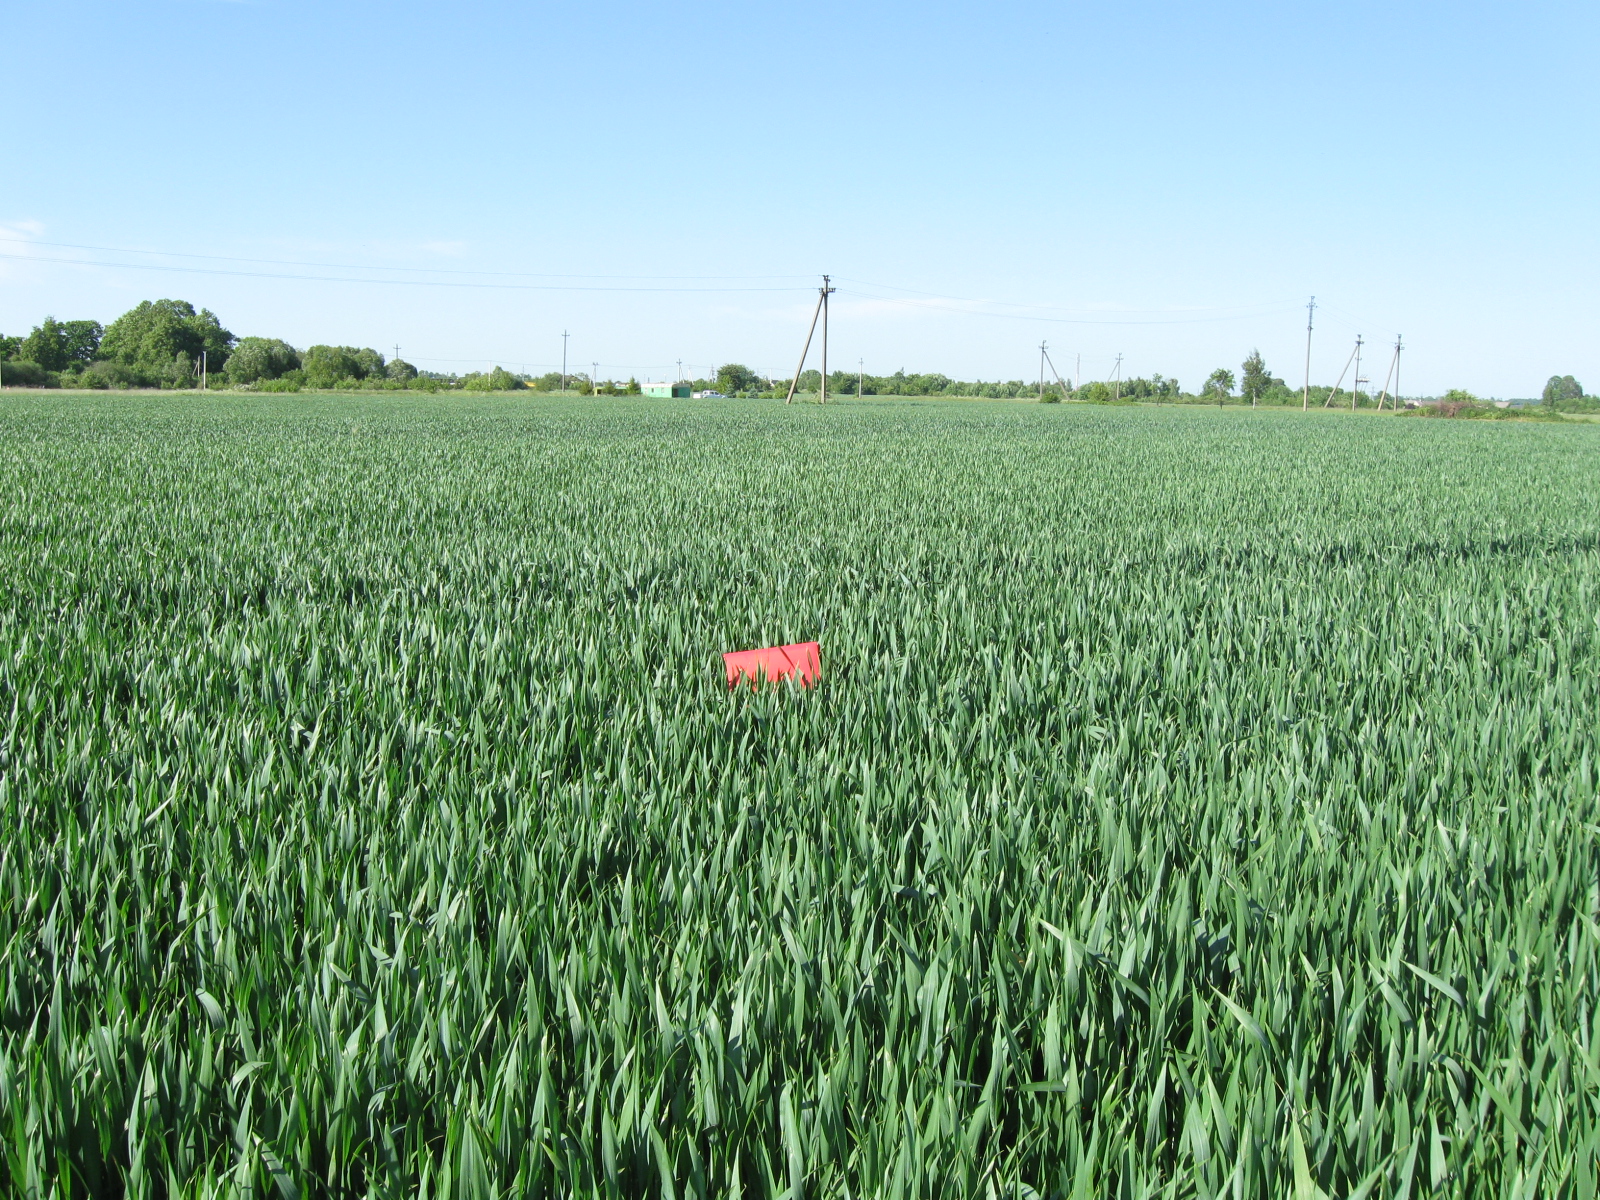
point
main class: Cropland
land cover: Common wheat
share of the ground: > 75 %
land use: Agriculture (excluding fallow land and kitchen gardens)
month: June
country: LT
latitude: 54.8344
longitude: 23.9623
